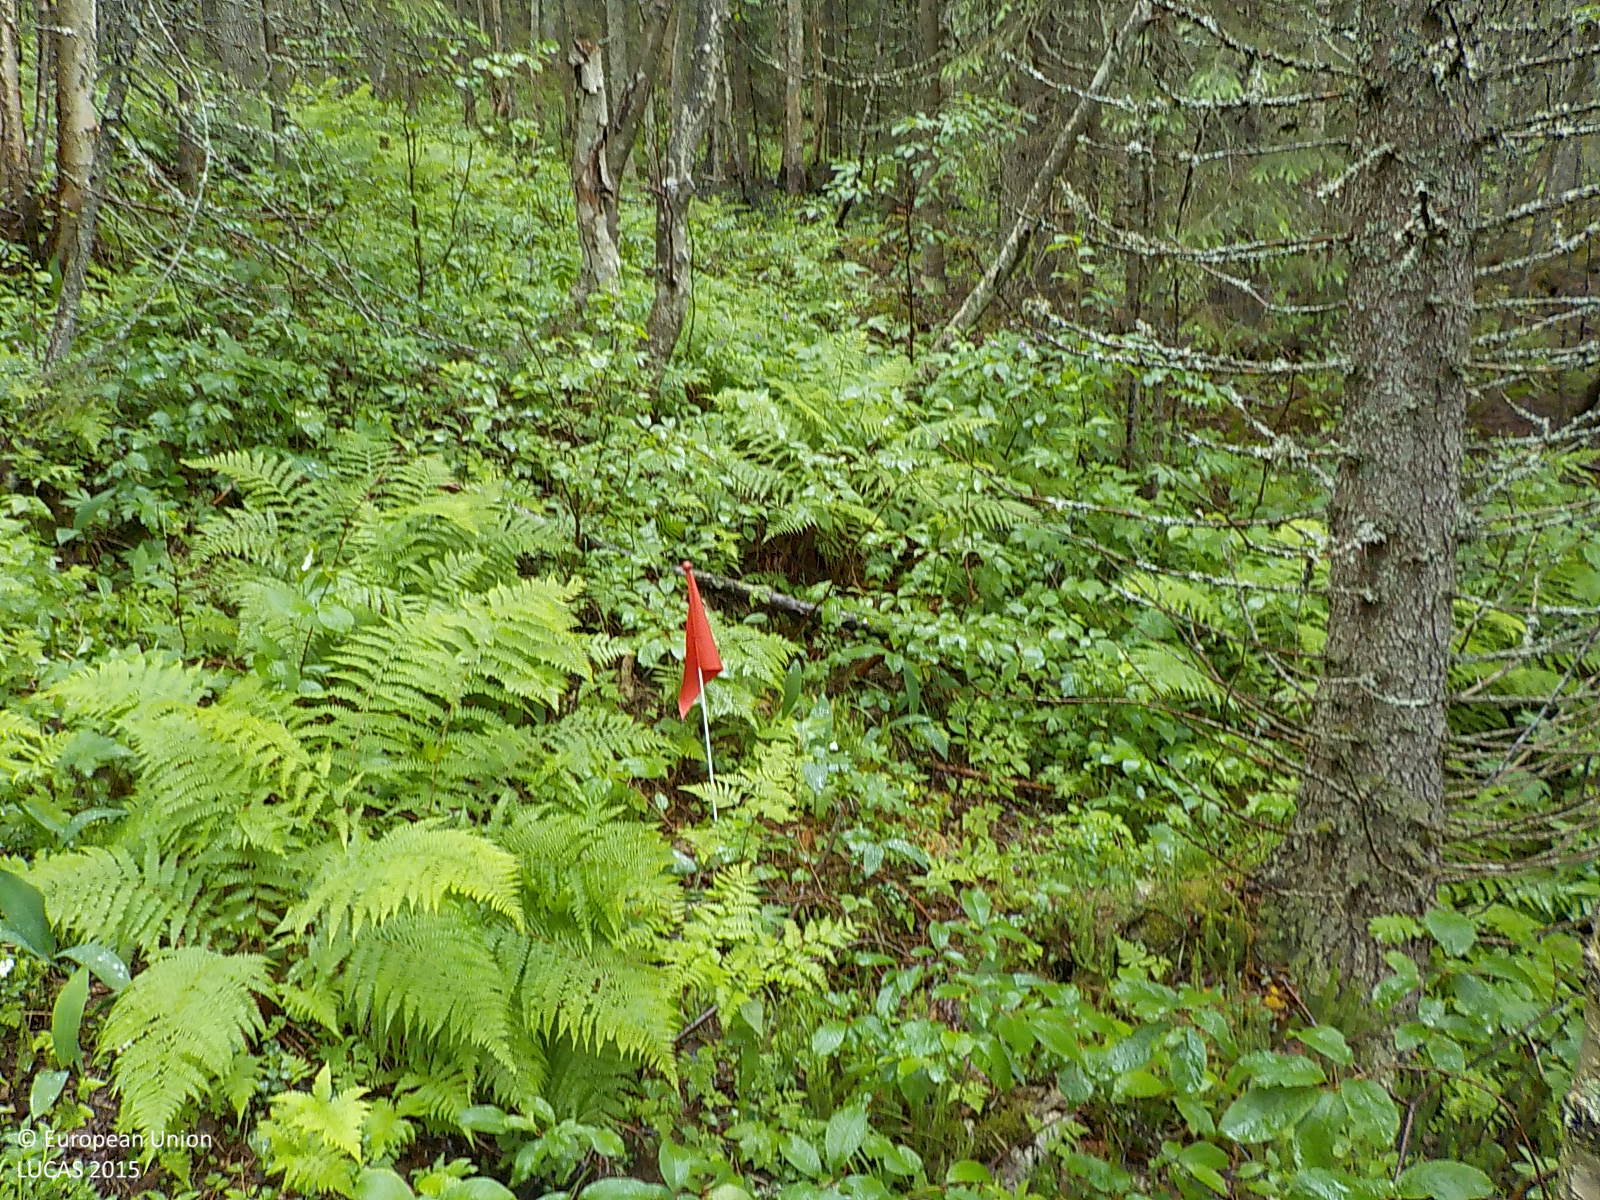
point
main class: Woodland
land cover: Spruce dominated mixed woodland
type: boreal forest
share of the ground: > 75 %
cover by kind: coniferous forest trees 60 %, broadleaved forest trees 20 %, herbaceous plants 20 %
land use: Forestry
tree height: > 5 m
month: July
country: SE
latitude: 63.0889
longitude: 17.9981
